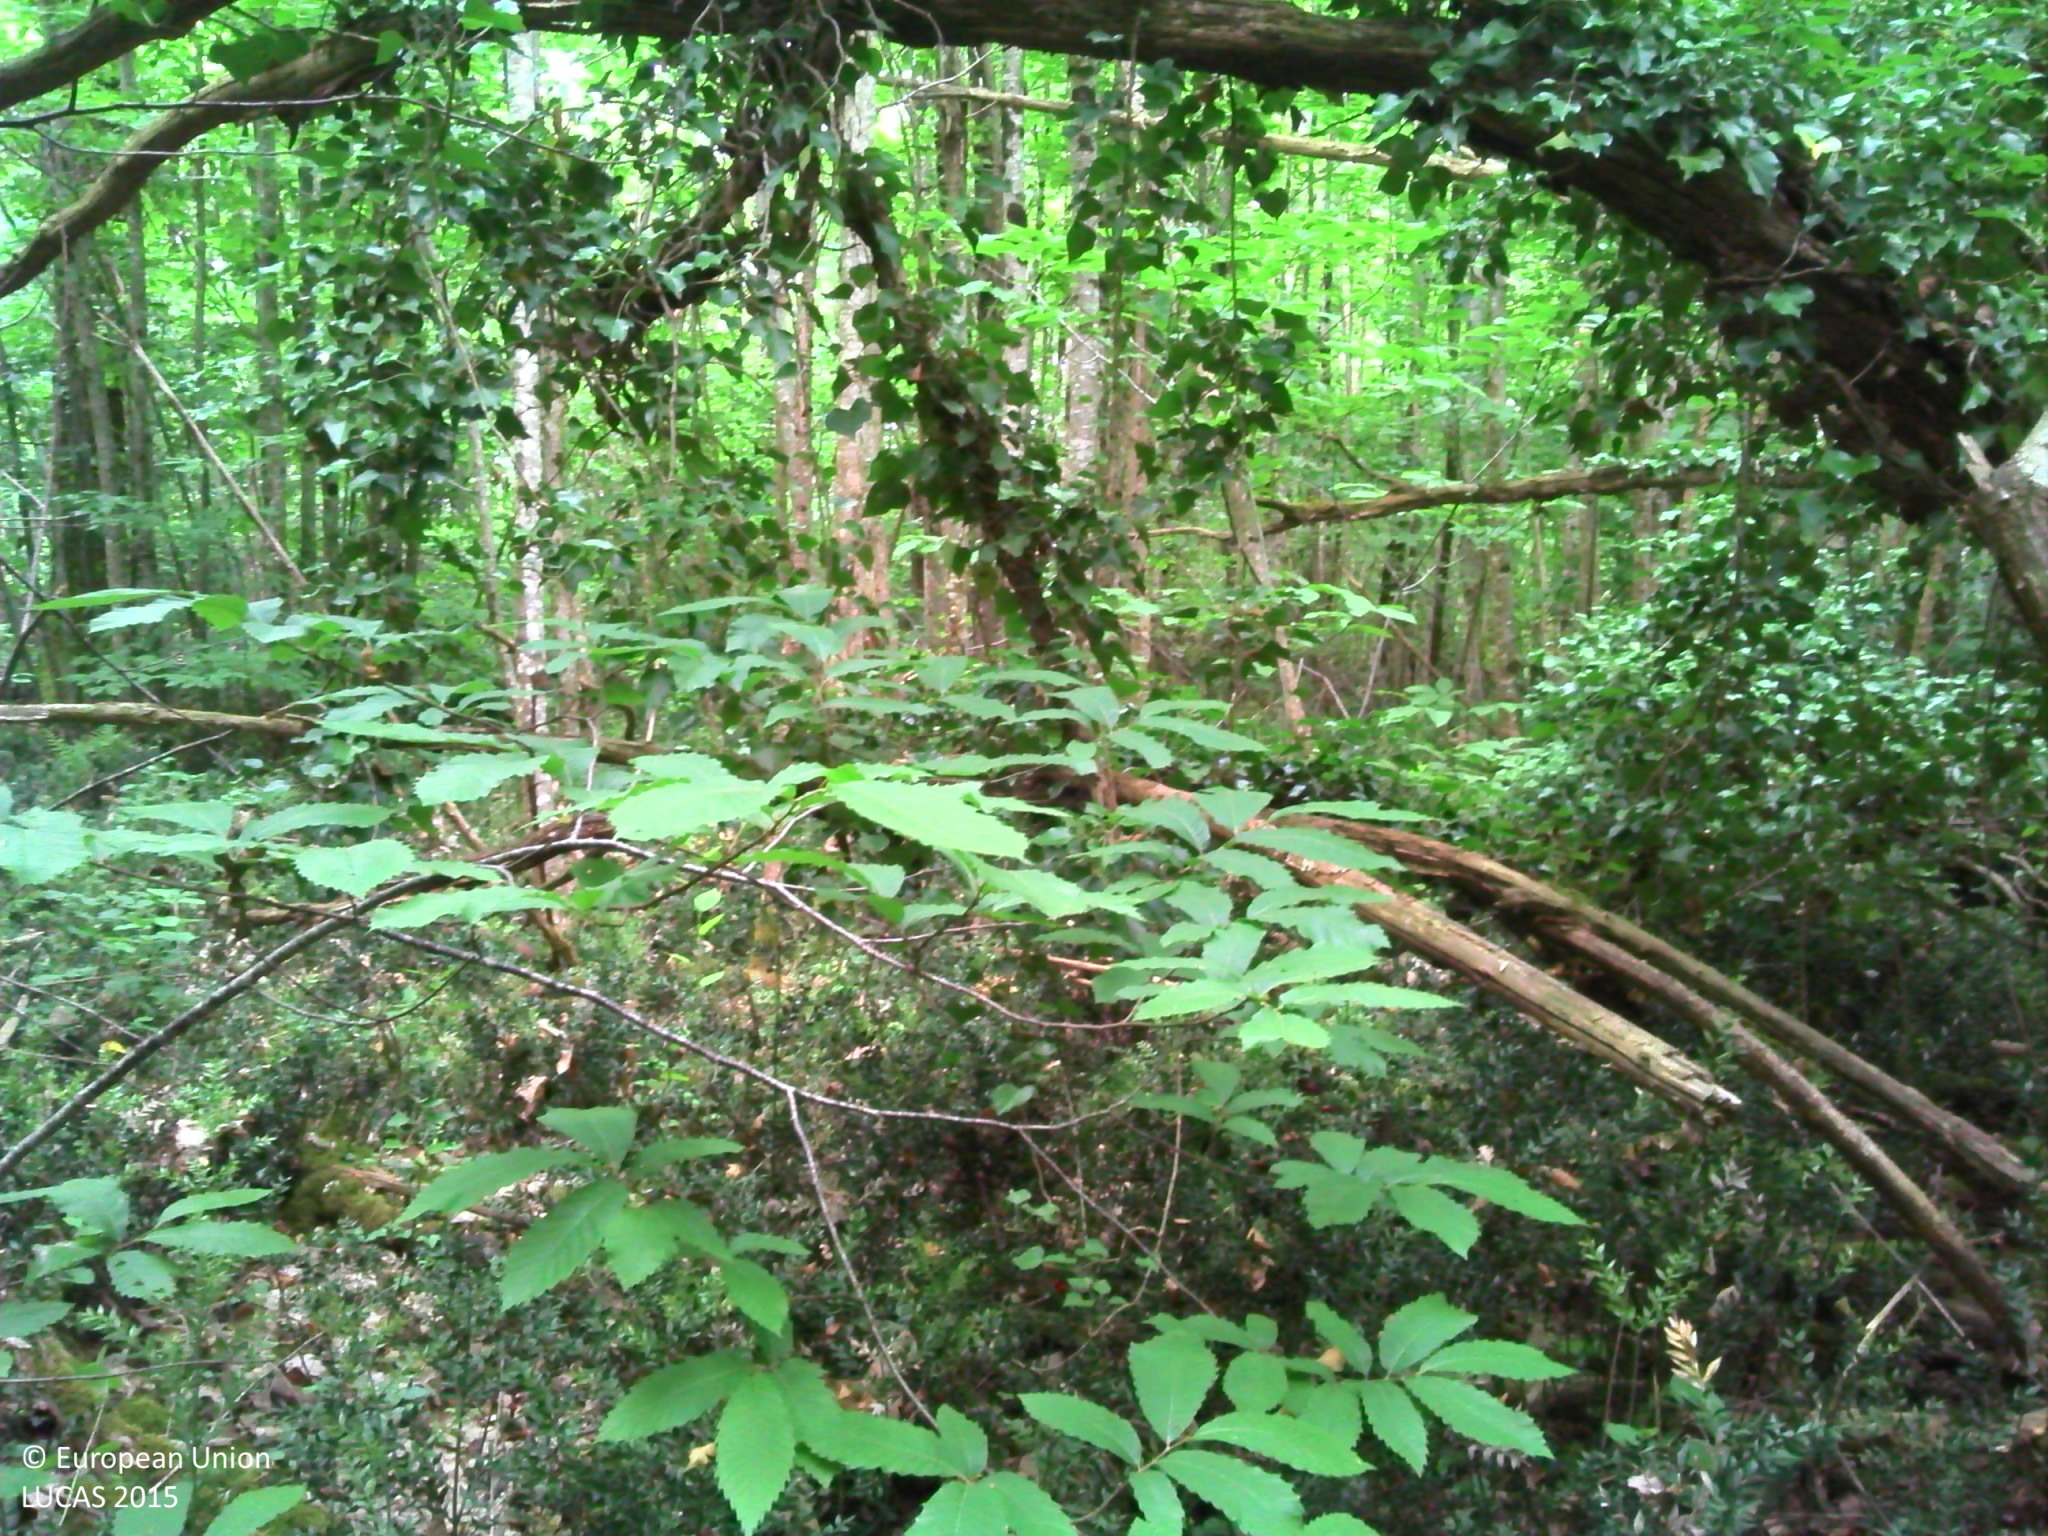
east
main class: Woodland
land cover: Broadleaved woodland
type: thermophilous deciduous forest
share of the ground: > 75 %
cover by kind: broadleaved forest trees 100 %
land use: Forestry
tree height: > 5 m
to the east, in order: Broadleaved woodland
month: June
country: FR
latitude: 45.9453
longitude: 0.2956
